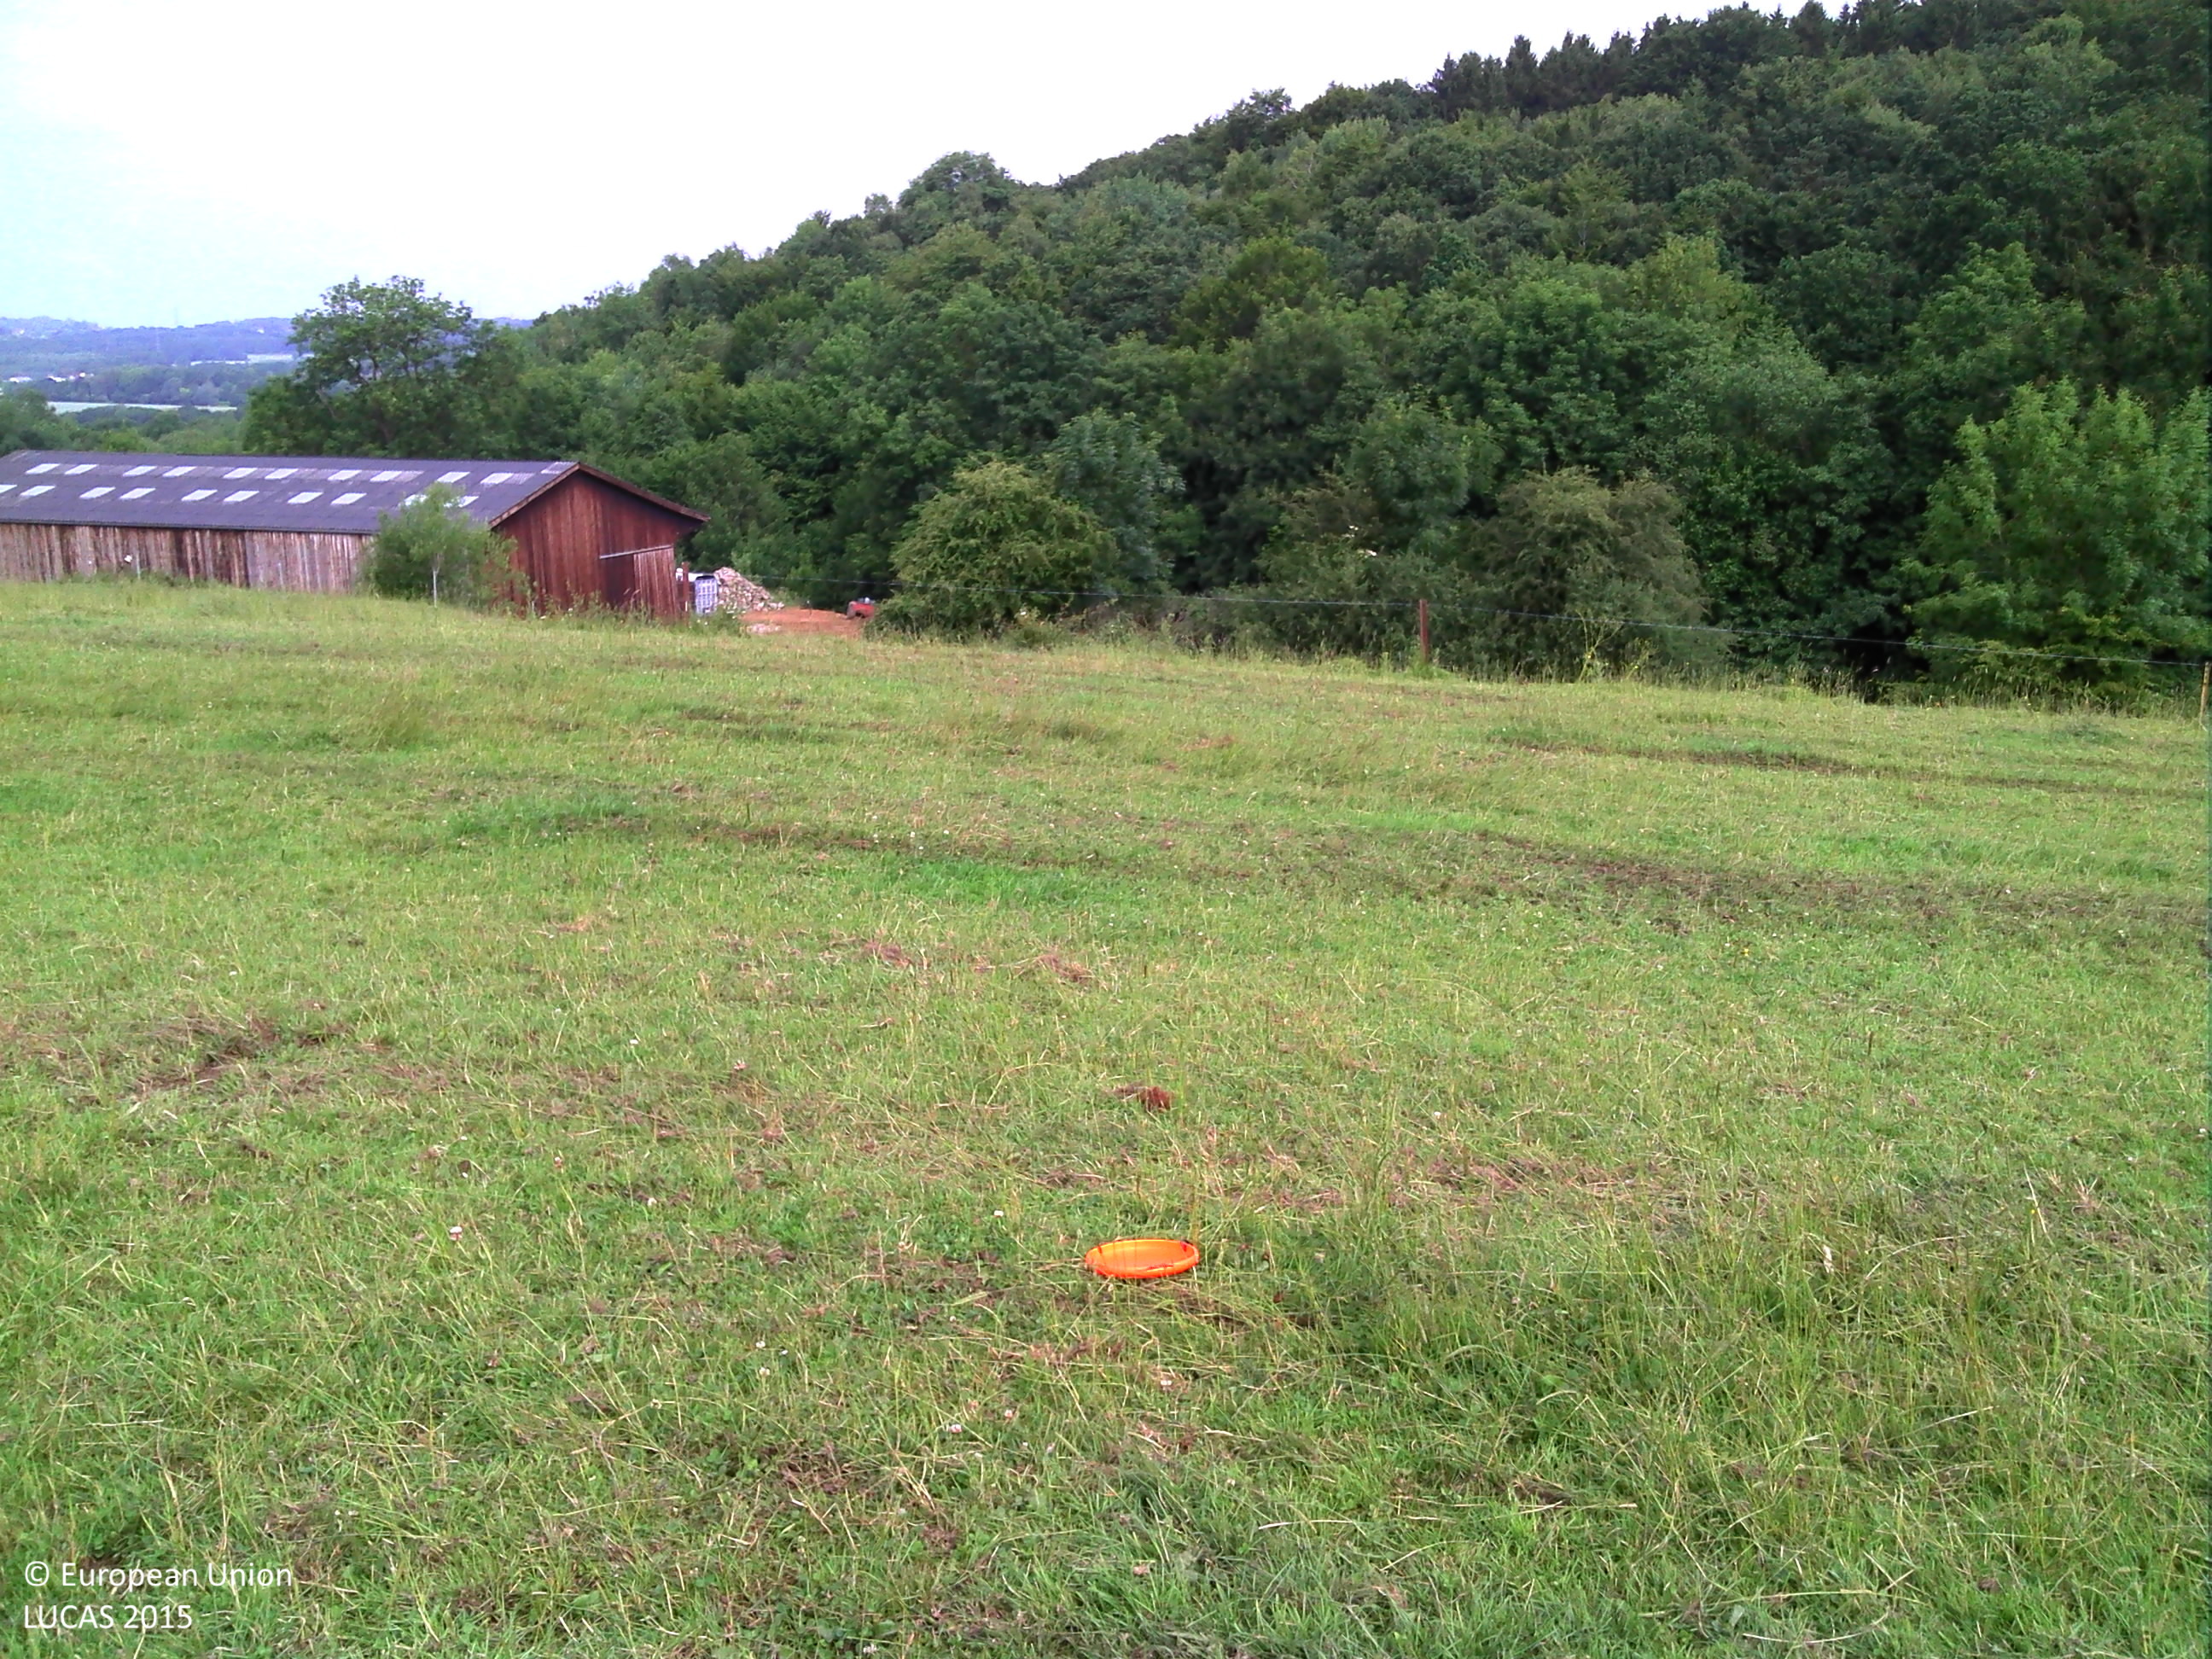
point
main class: Grassland
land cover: Grassland without tree/shrub cover
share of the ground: > 75 %
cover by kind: herbaceous plants 100 %
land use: Agriculture (excluding fallow land and kitchen gardens)
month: June
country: BE
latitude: 50.5097
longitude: 5.4999
